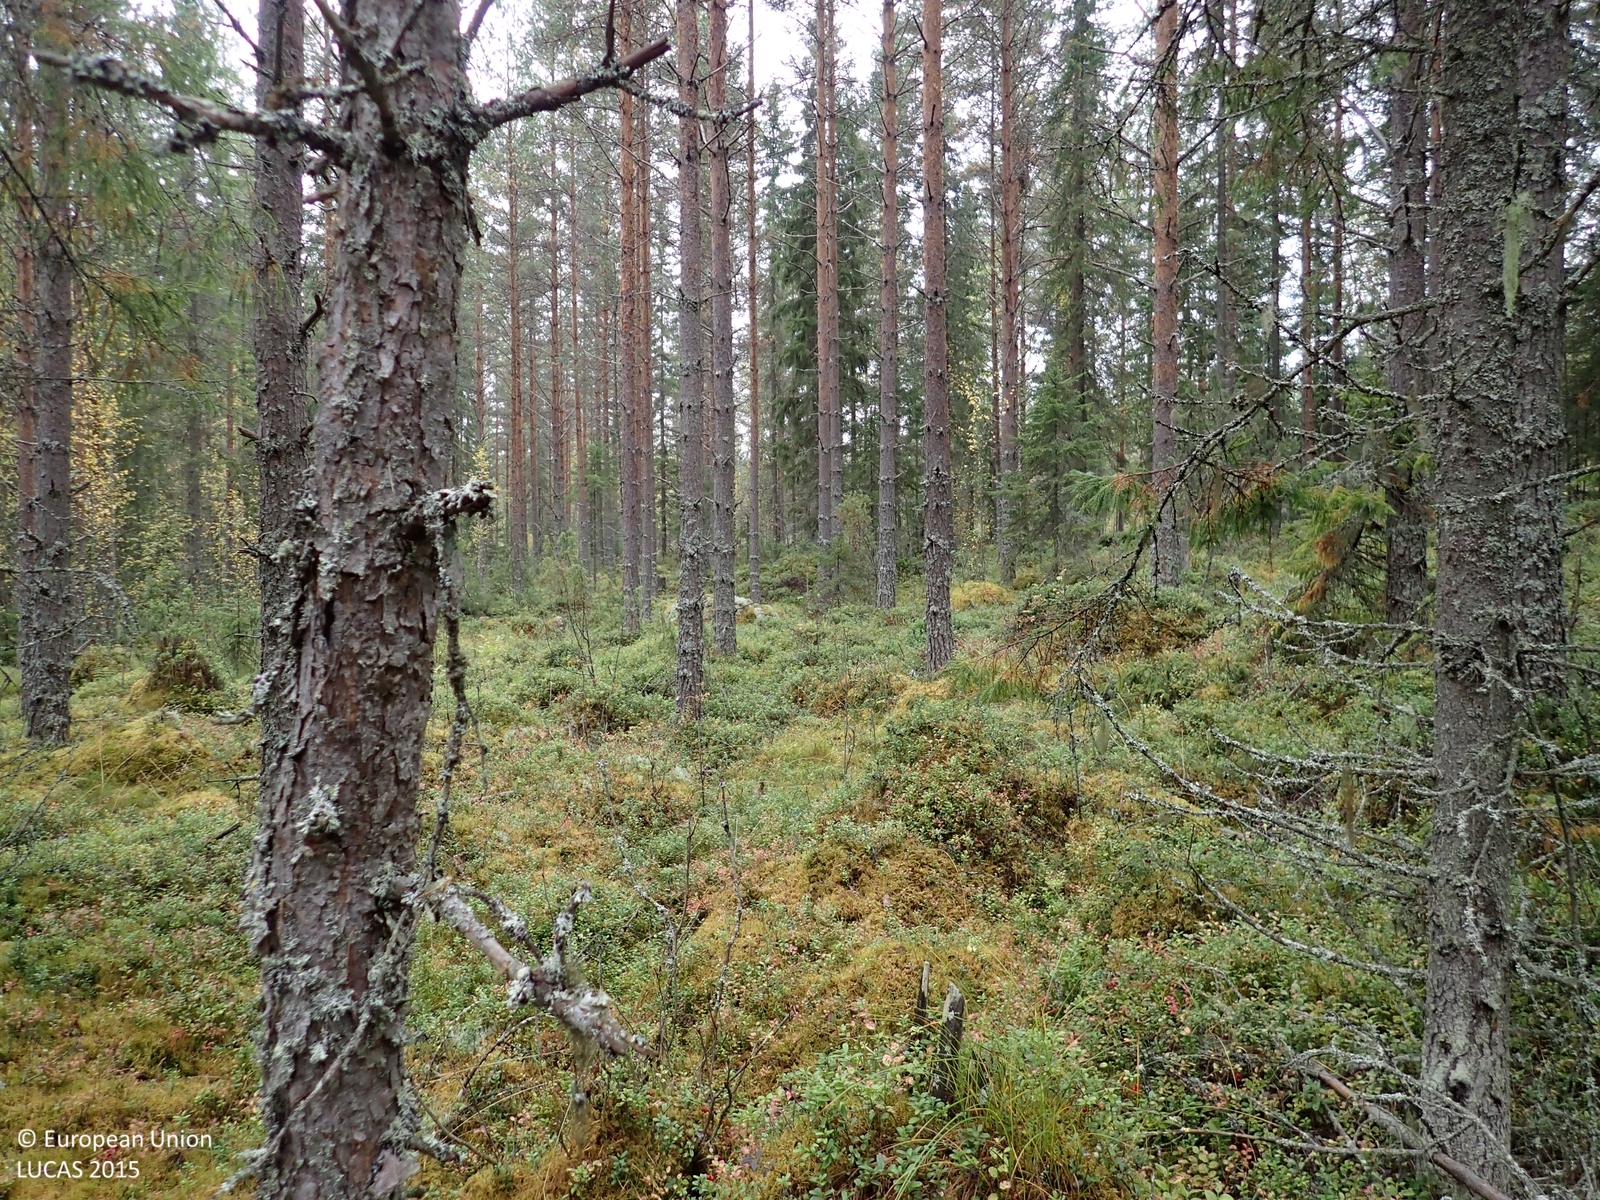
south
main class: Woodland
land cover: Other coniferous woodland
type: boreal forest
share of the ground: > 75 %
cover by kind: coniferous forest trees 70 %, shrubs 20 %, broadleaved forest trees 5 %, lichens and mosses 5 %
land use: Forestry
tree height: > 5 m
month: September
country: FI
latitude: 63.2616
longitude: 25.6670
